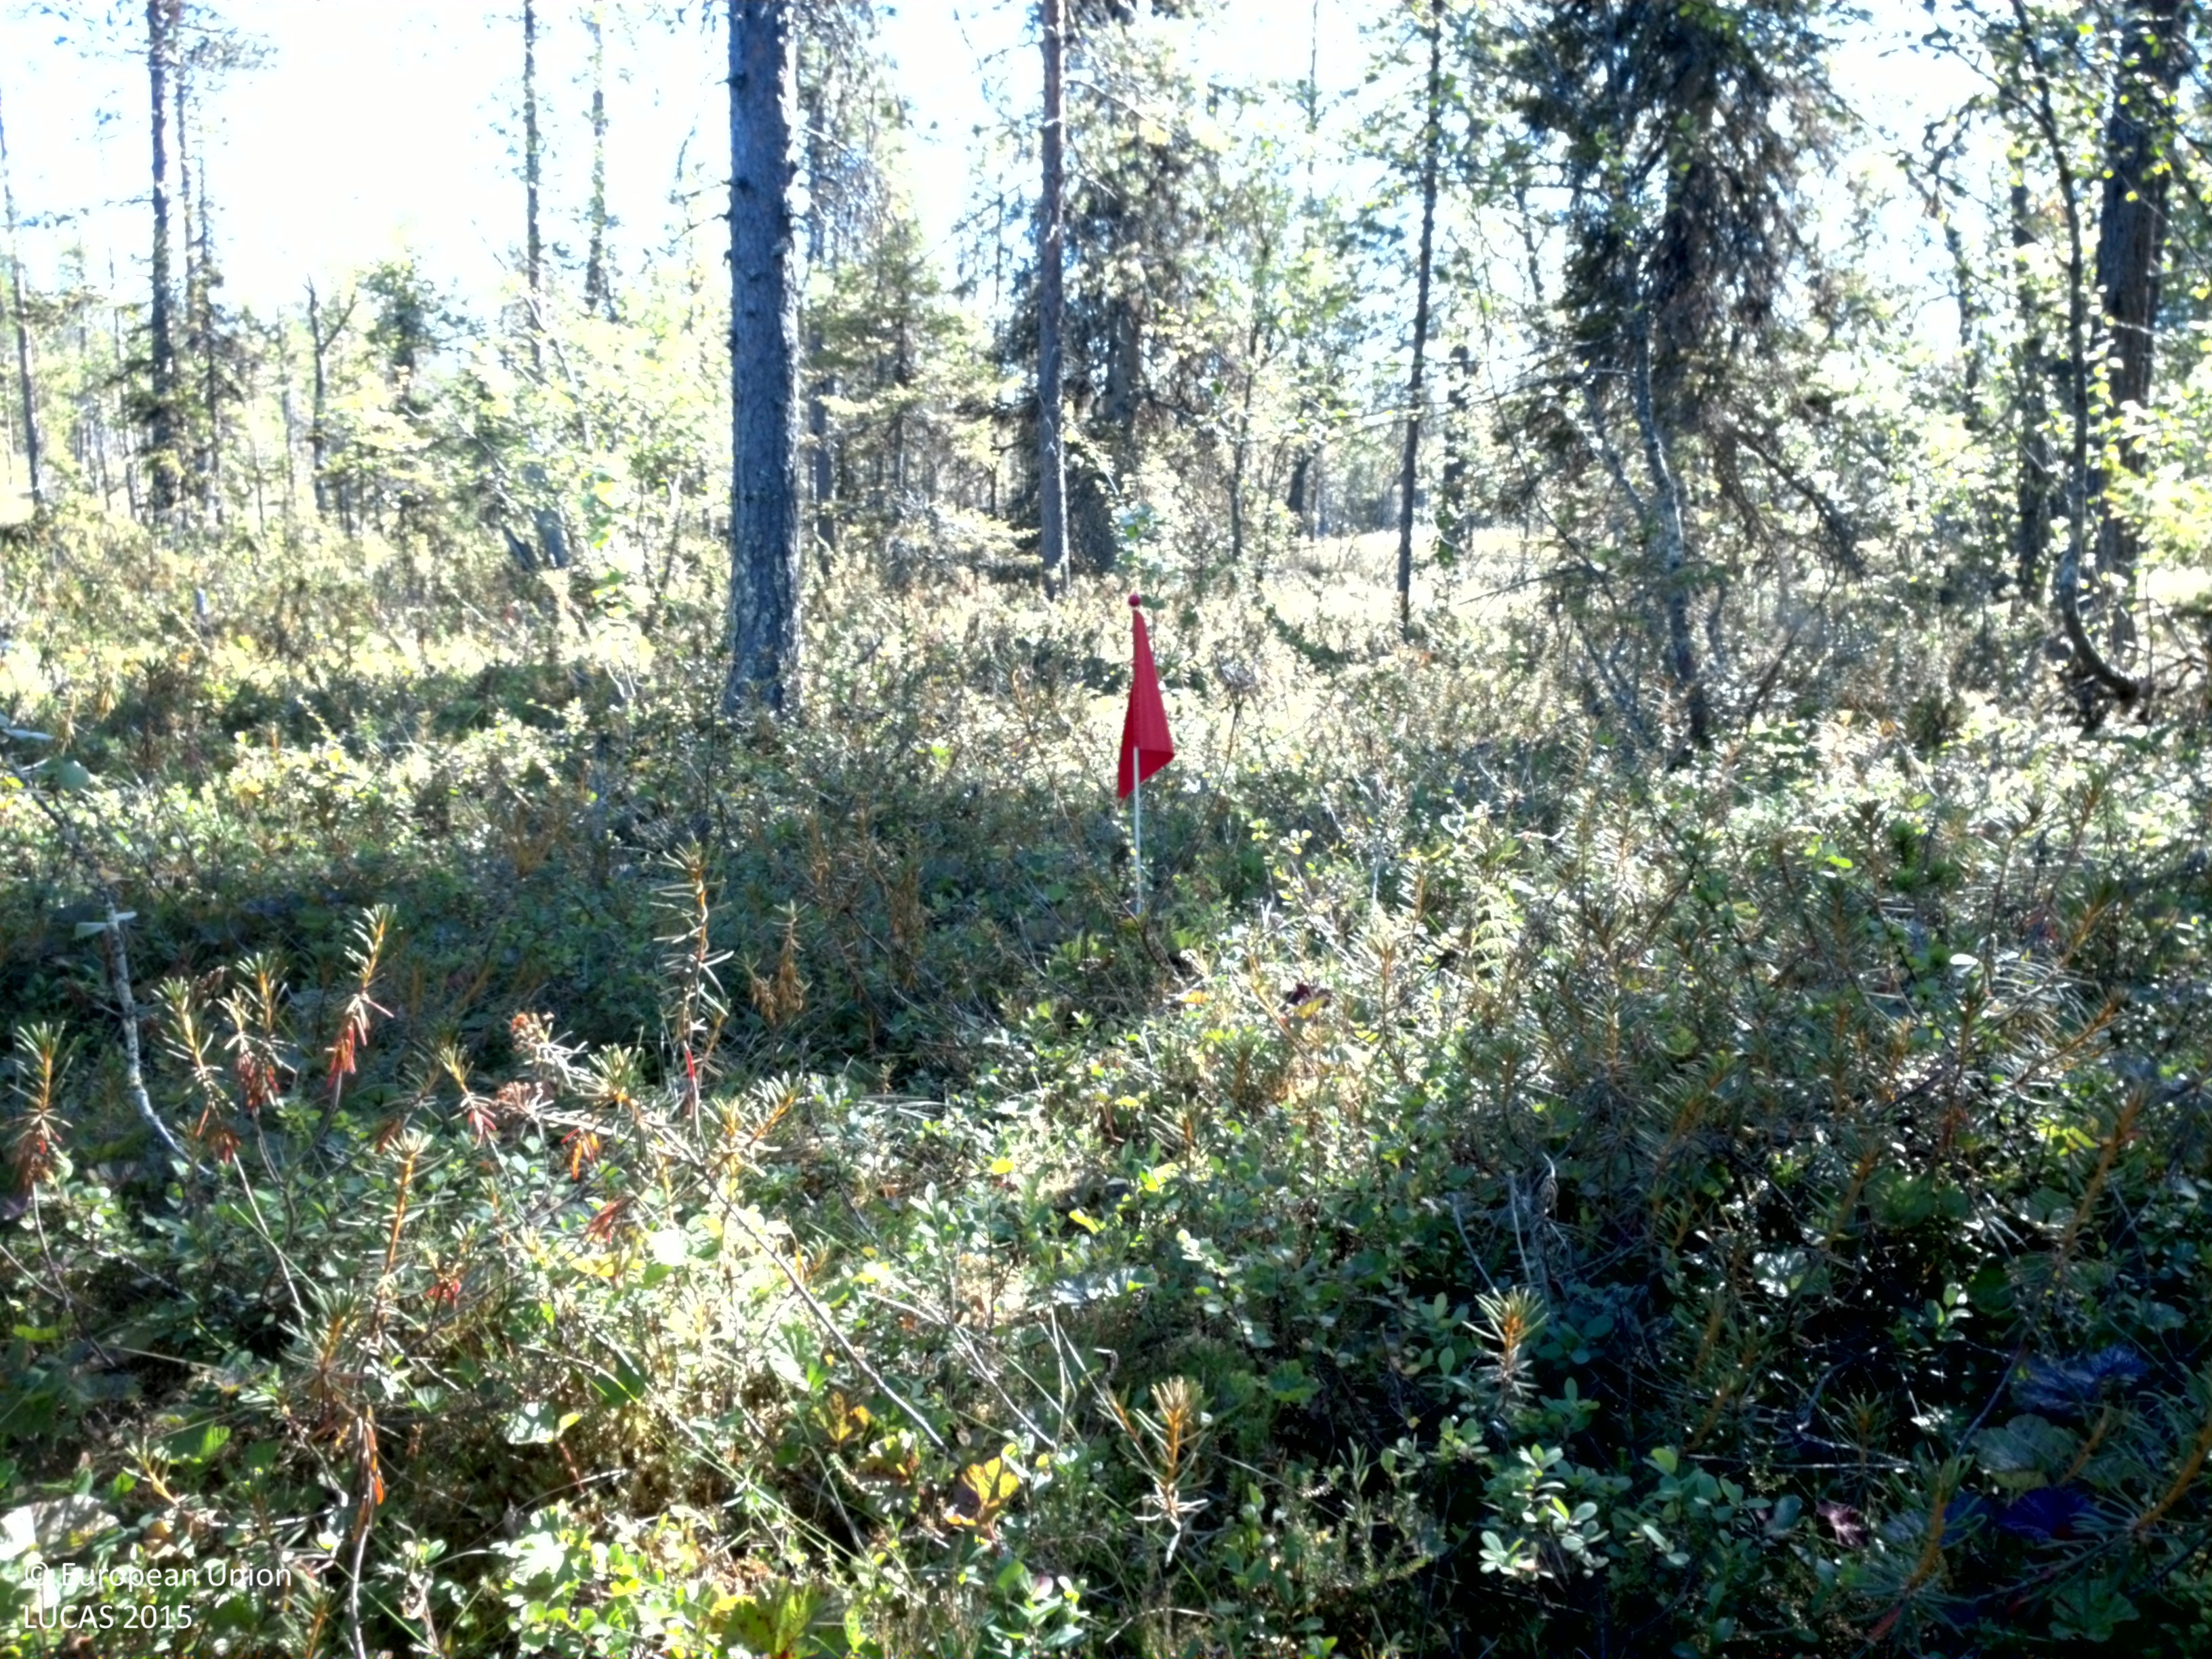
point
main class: Woodland
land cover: Pine dominated coniferous woodland
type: boreal forest
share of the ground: 25 - 50 %
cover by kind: shrubs 70 %, coniferous forest trees 25 %, broadleaved forest trees 5 %
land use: Forestry
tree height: > 5 m
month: August
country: SE
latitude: 66.6287
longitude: 18.8282
